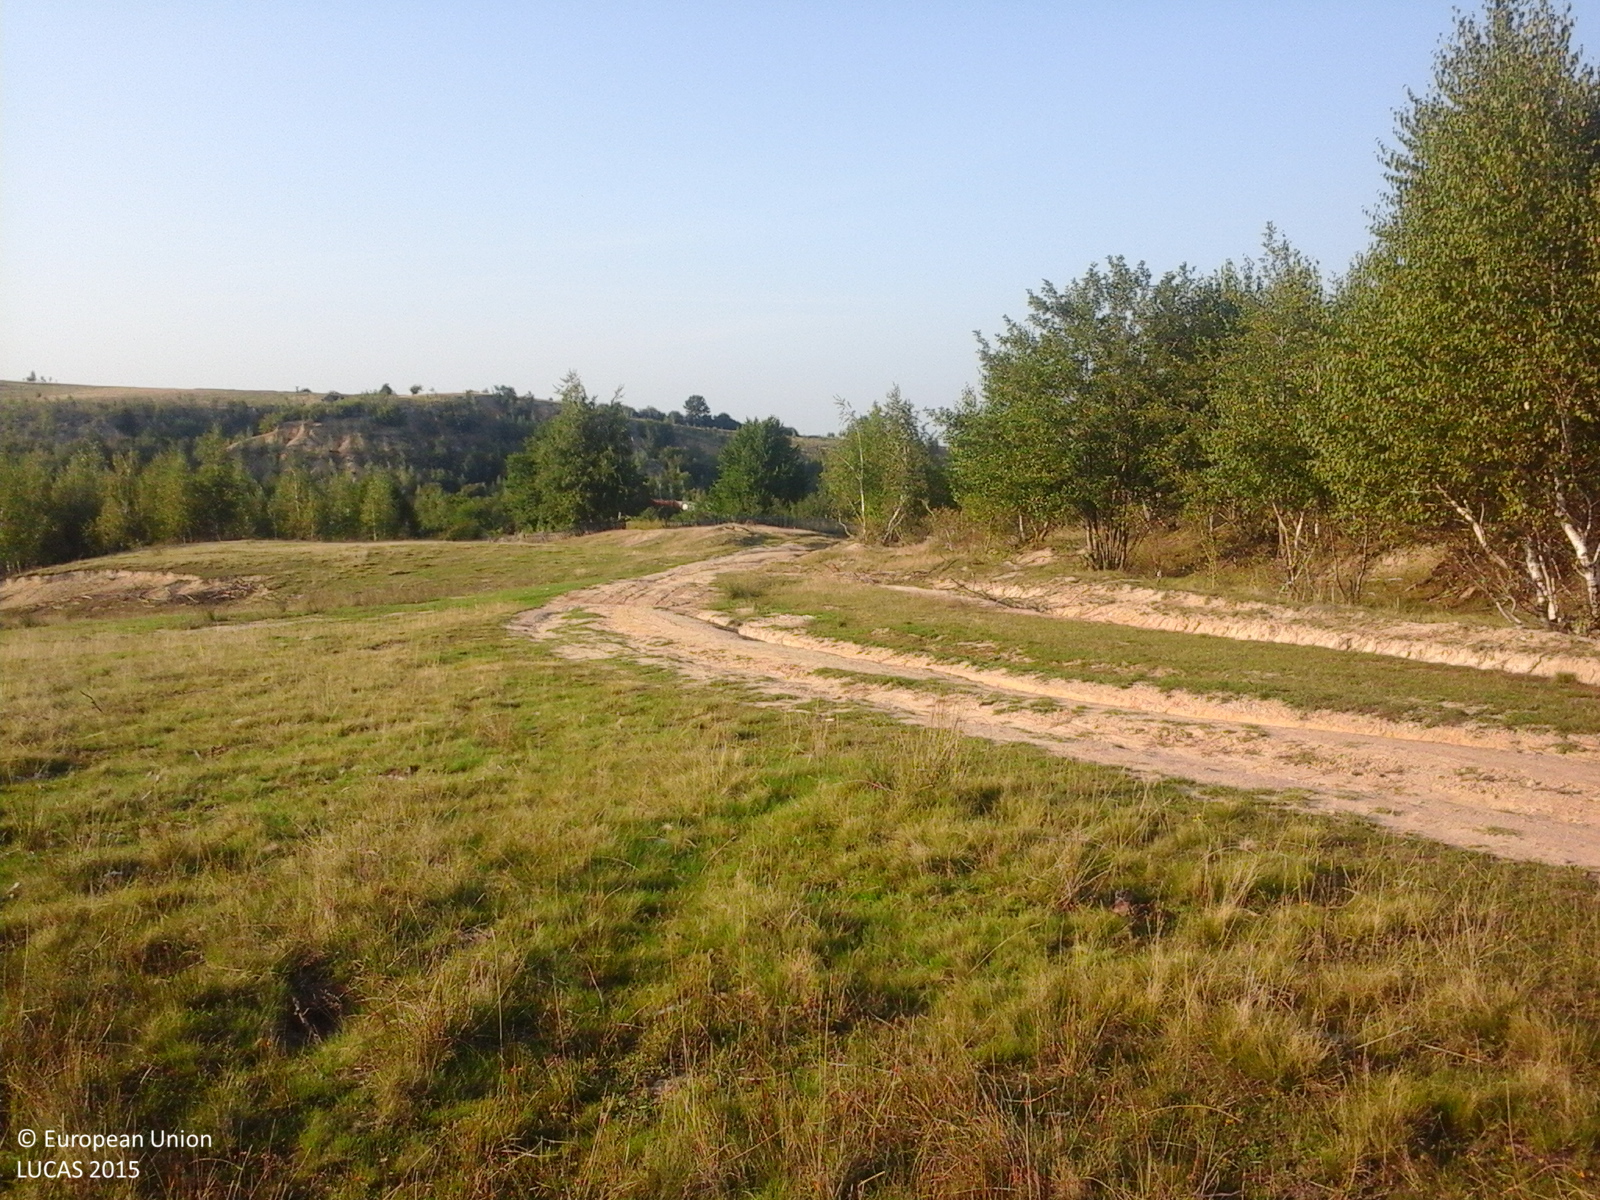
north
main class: Grassland
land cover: Grassland without tree/shrub cover
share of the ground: > 75 %
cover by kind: herbaceous plants 100 %
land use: Agriculture (excluding fallow land and kitchen gardens)
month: September
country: RO
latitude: 47.1098
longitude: 22.6422
